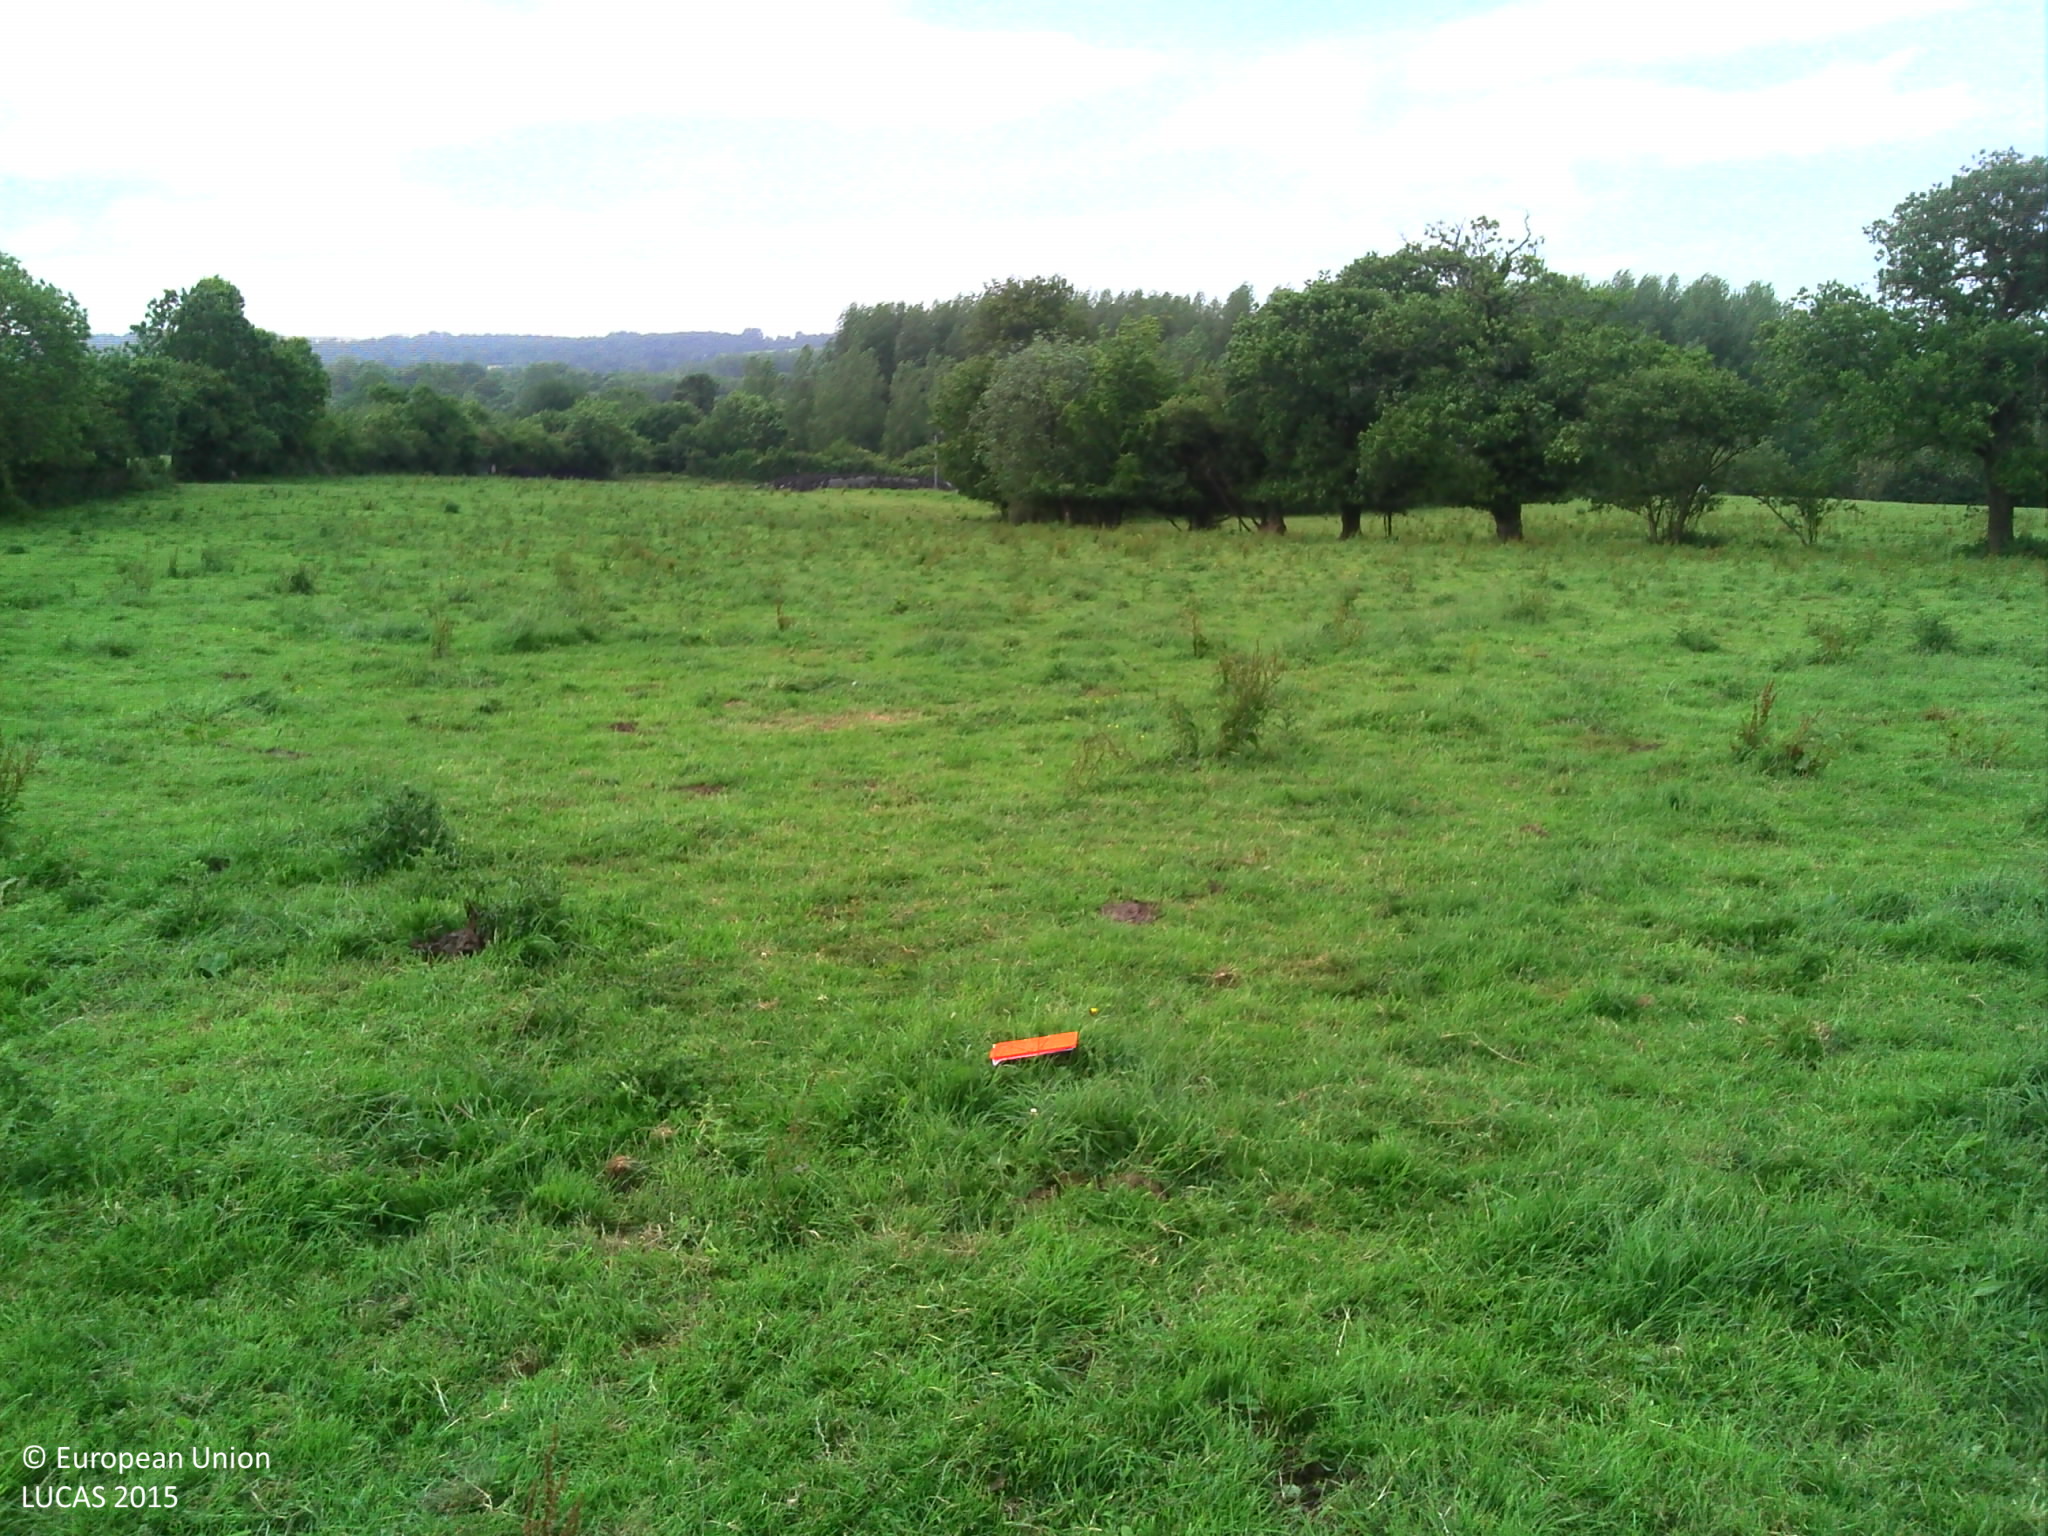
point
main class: Grassland
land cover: Grassland without tree/shrub cover
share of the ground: > 75 %
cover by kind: herbaceous plants 95 %, shrubs 5 %
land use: Agriculture (excluding fallow land and kitchen gardens)
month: June
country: FR
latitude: 49.5356
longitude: -1.4207
